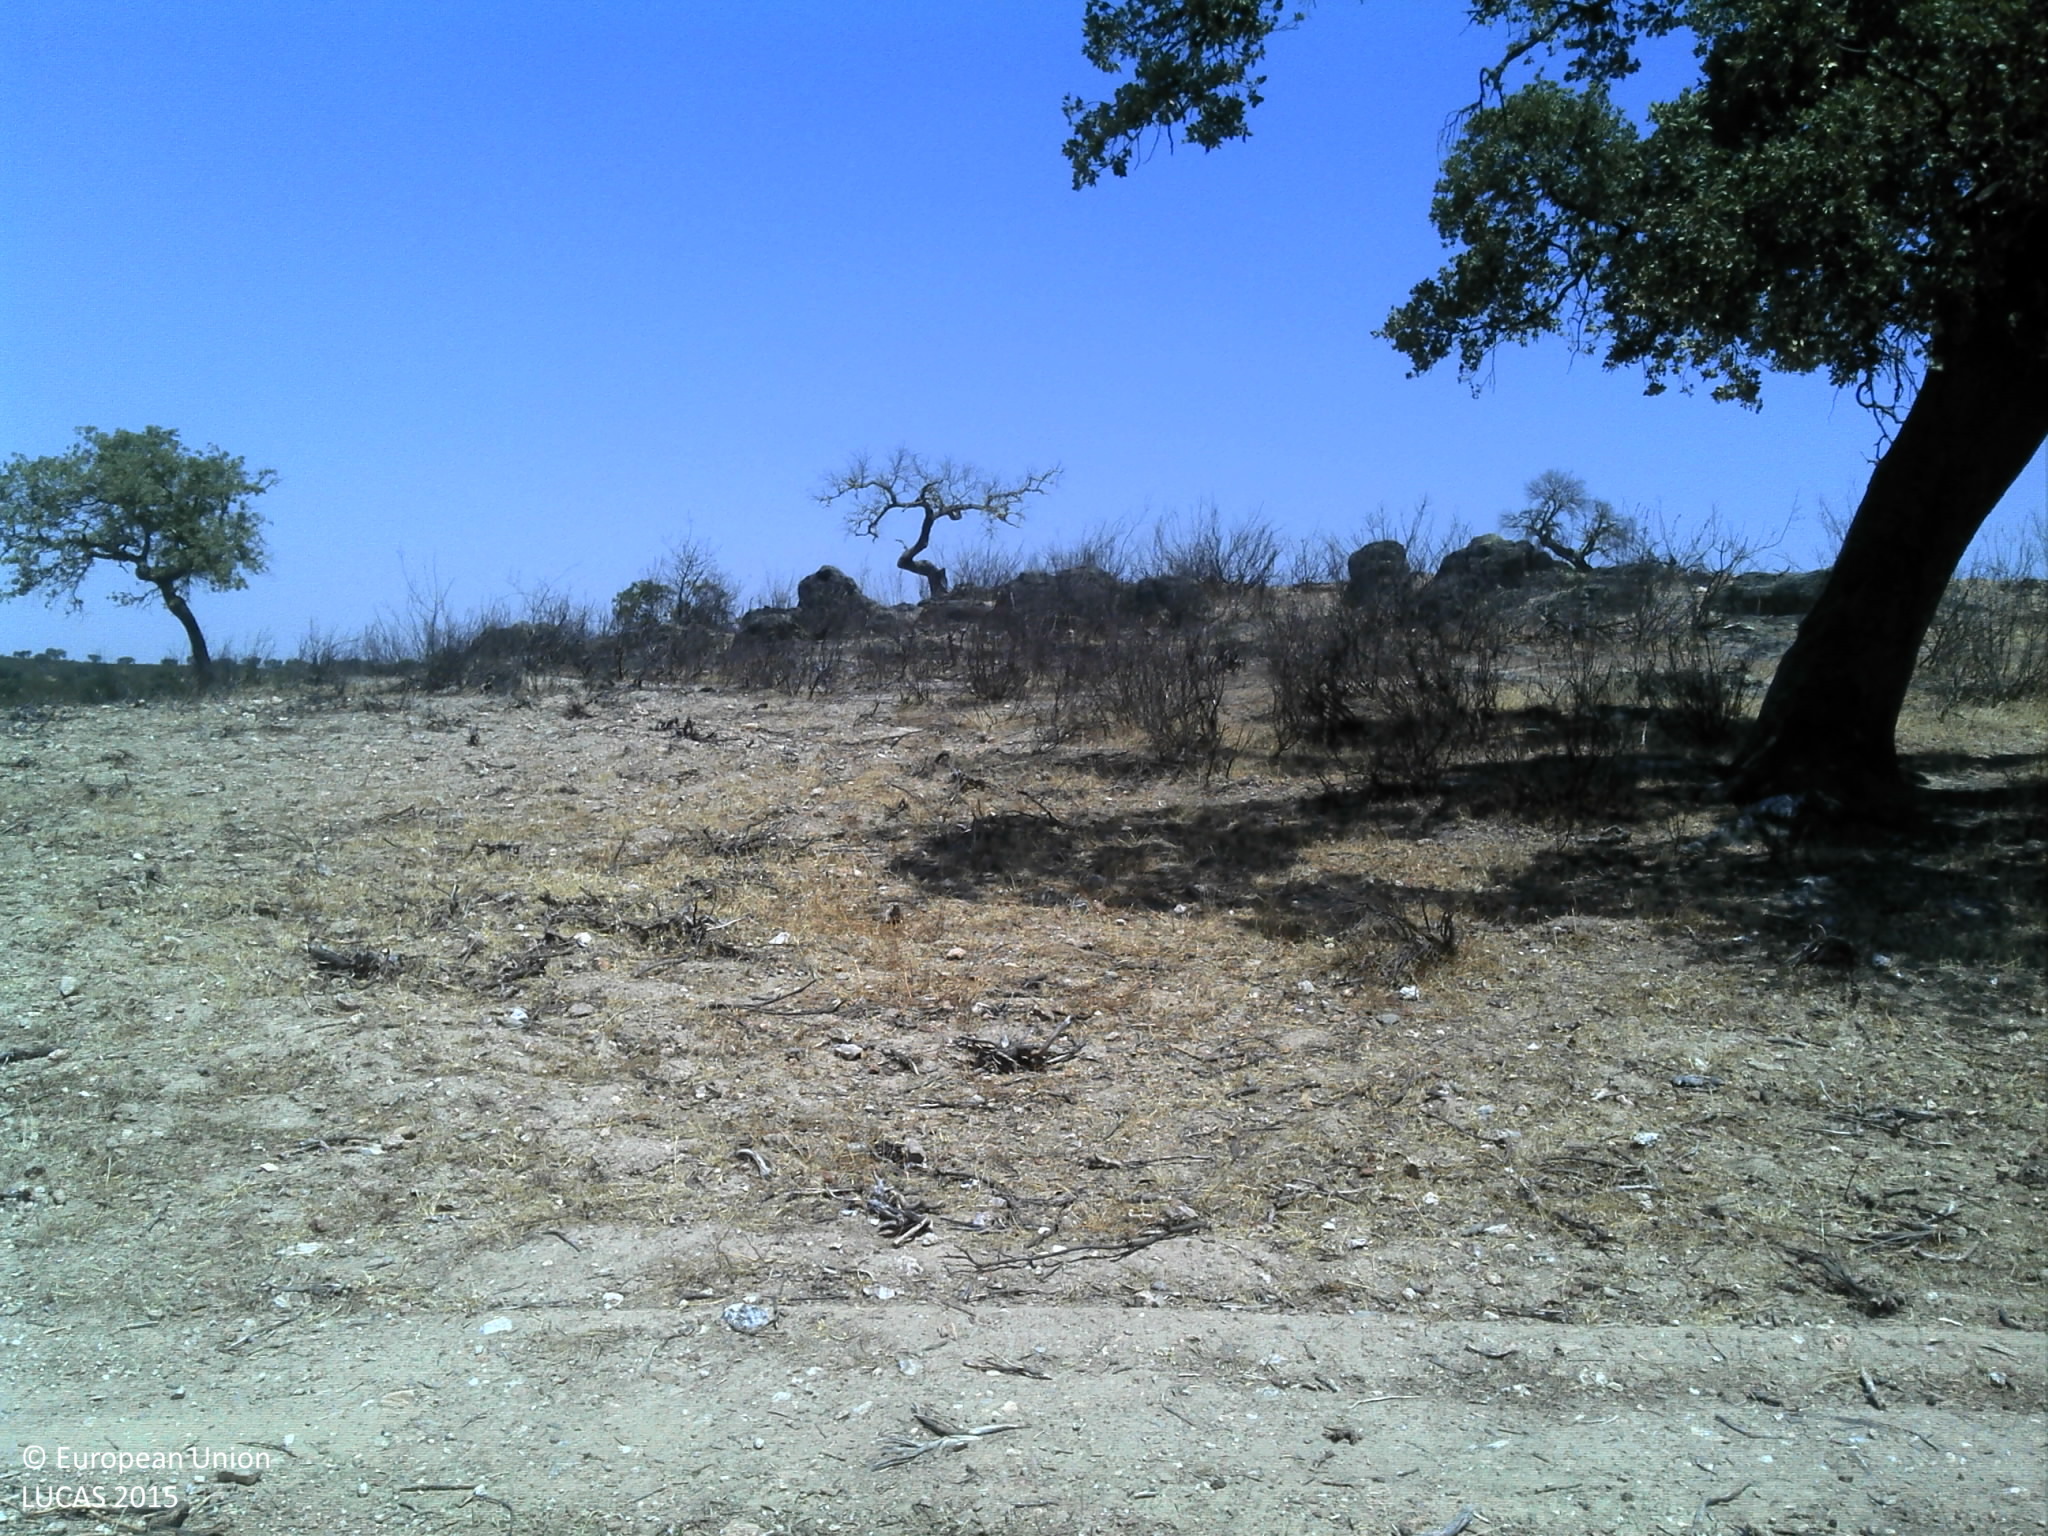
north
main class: Woodland
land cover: Broadleaved woodland
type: broadleaved evergreen forest
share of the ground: 10 - 25 %
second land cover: Grassland without tree/shrub cover
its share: 10 - 25 %
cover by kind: herbaceous plants 65 %, unconsolidated bare surface 25 %, broadleaved forest trees 10 %
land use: Forestry
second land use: Agriculture (excluding fallow land and kitchen gardens)
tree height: < 5 m
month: June
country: PT
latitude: 38.0804
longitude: -7.1479
